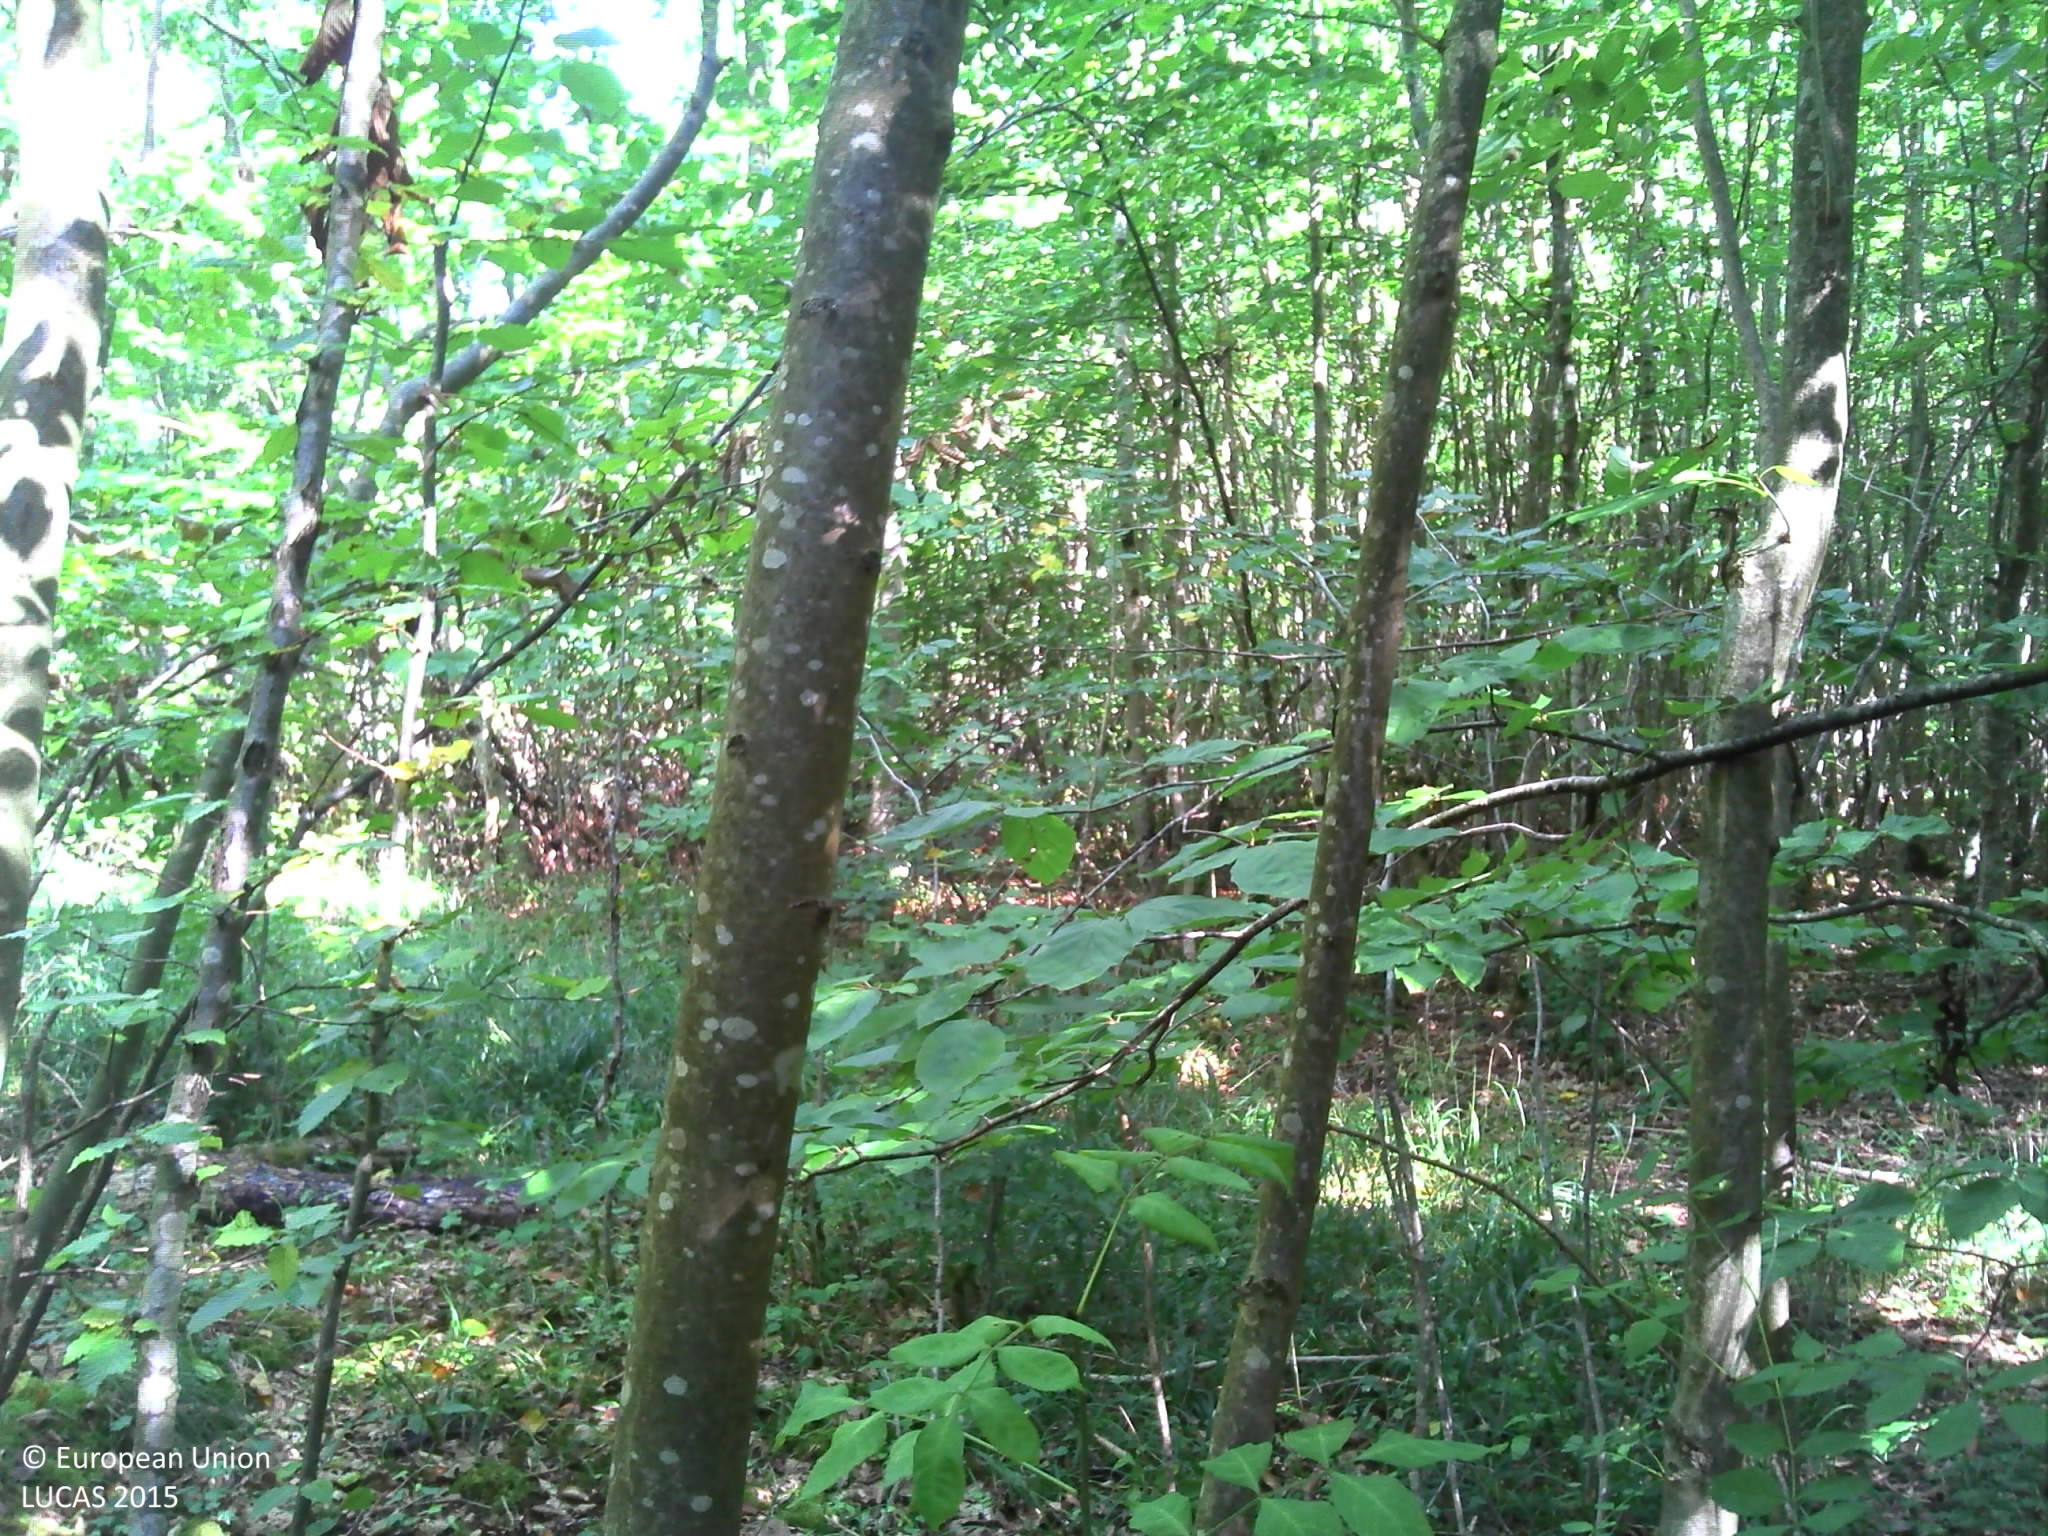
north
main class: Woodland
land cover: Broadleaved woodland
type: beech forest
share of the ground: > 75 %
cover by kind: broadleaved forest trees 90 %, herbaceous plants 5 %, consolidated bare surface 5 %
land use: Forestry
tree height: > 5 m
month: September
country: FR
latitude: 48.5635
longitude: 5.9482
